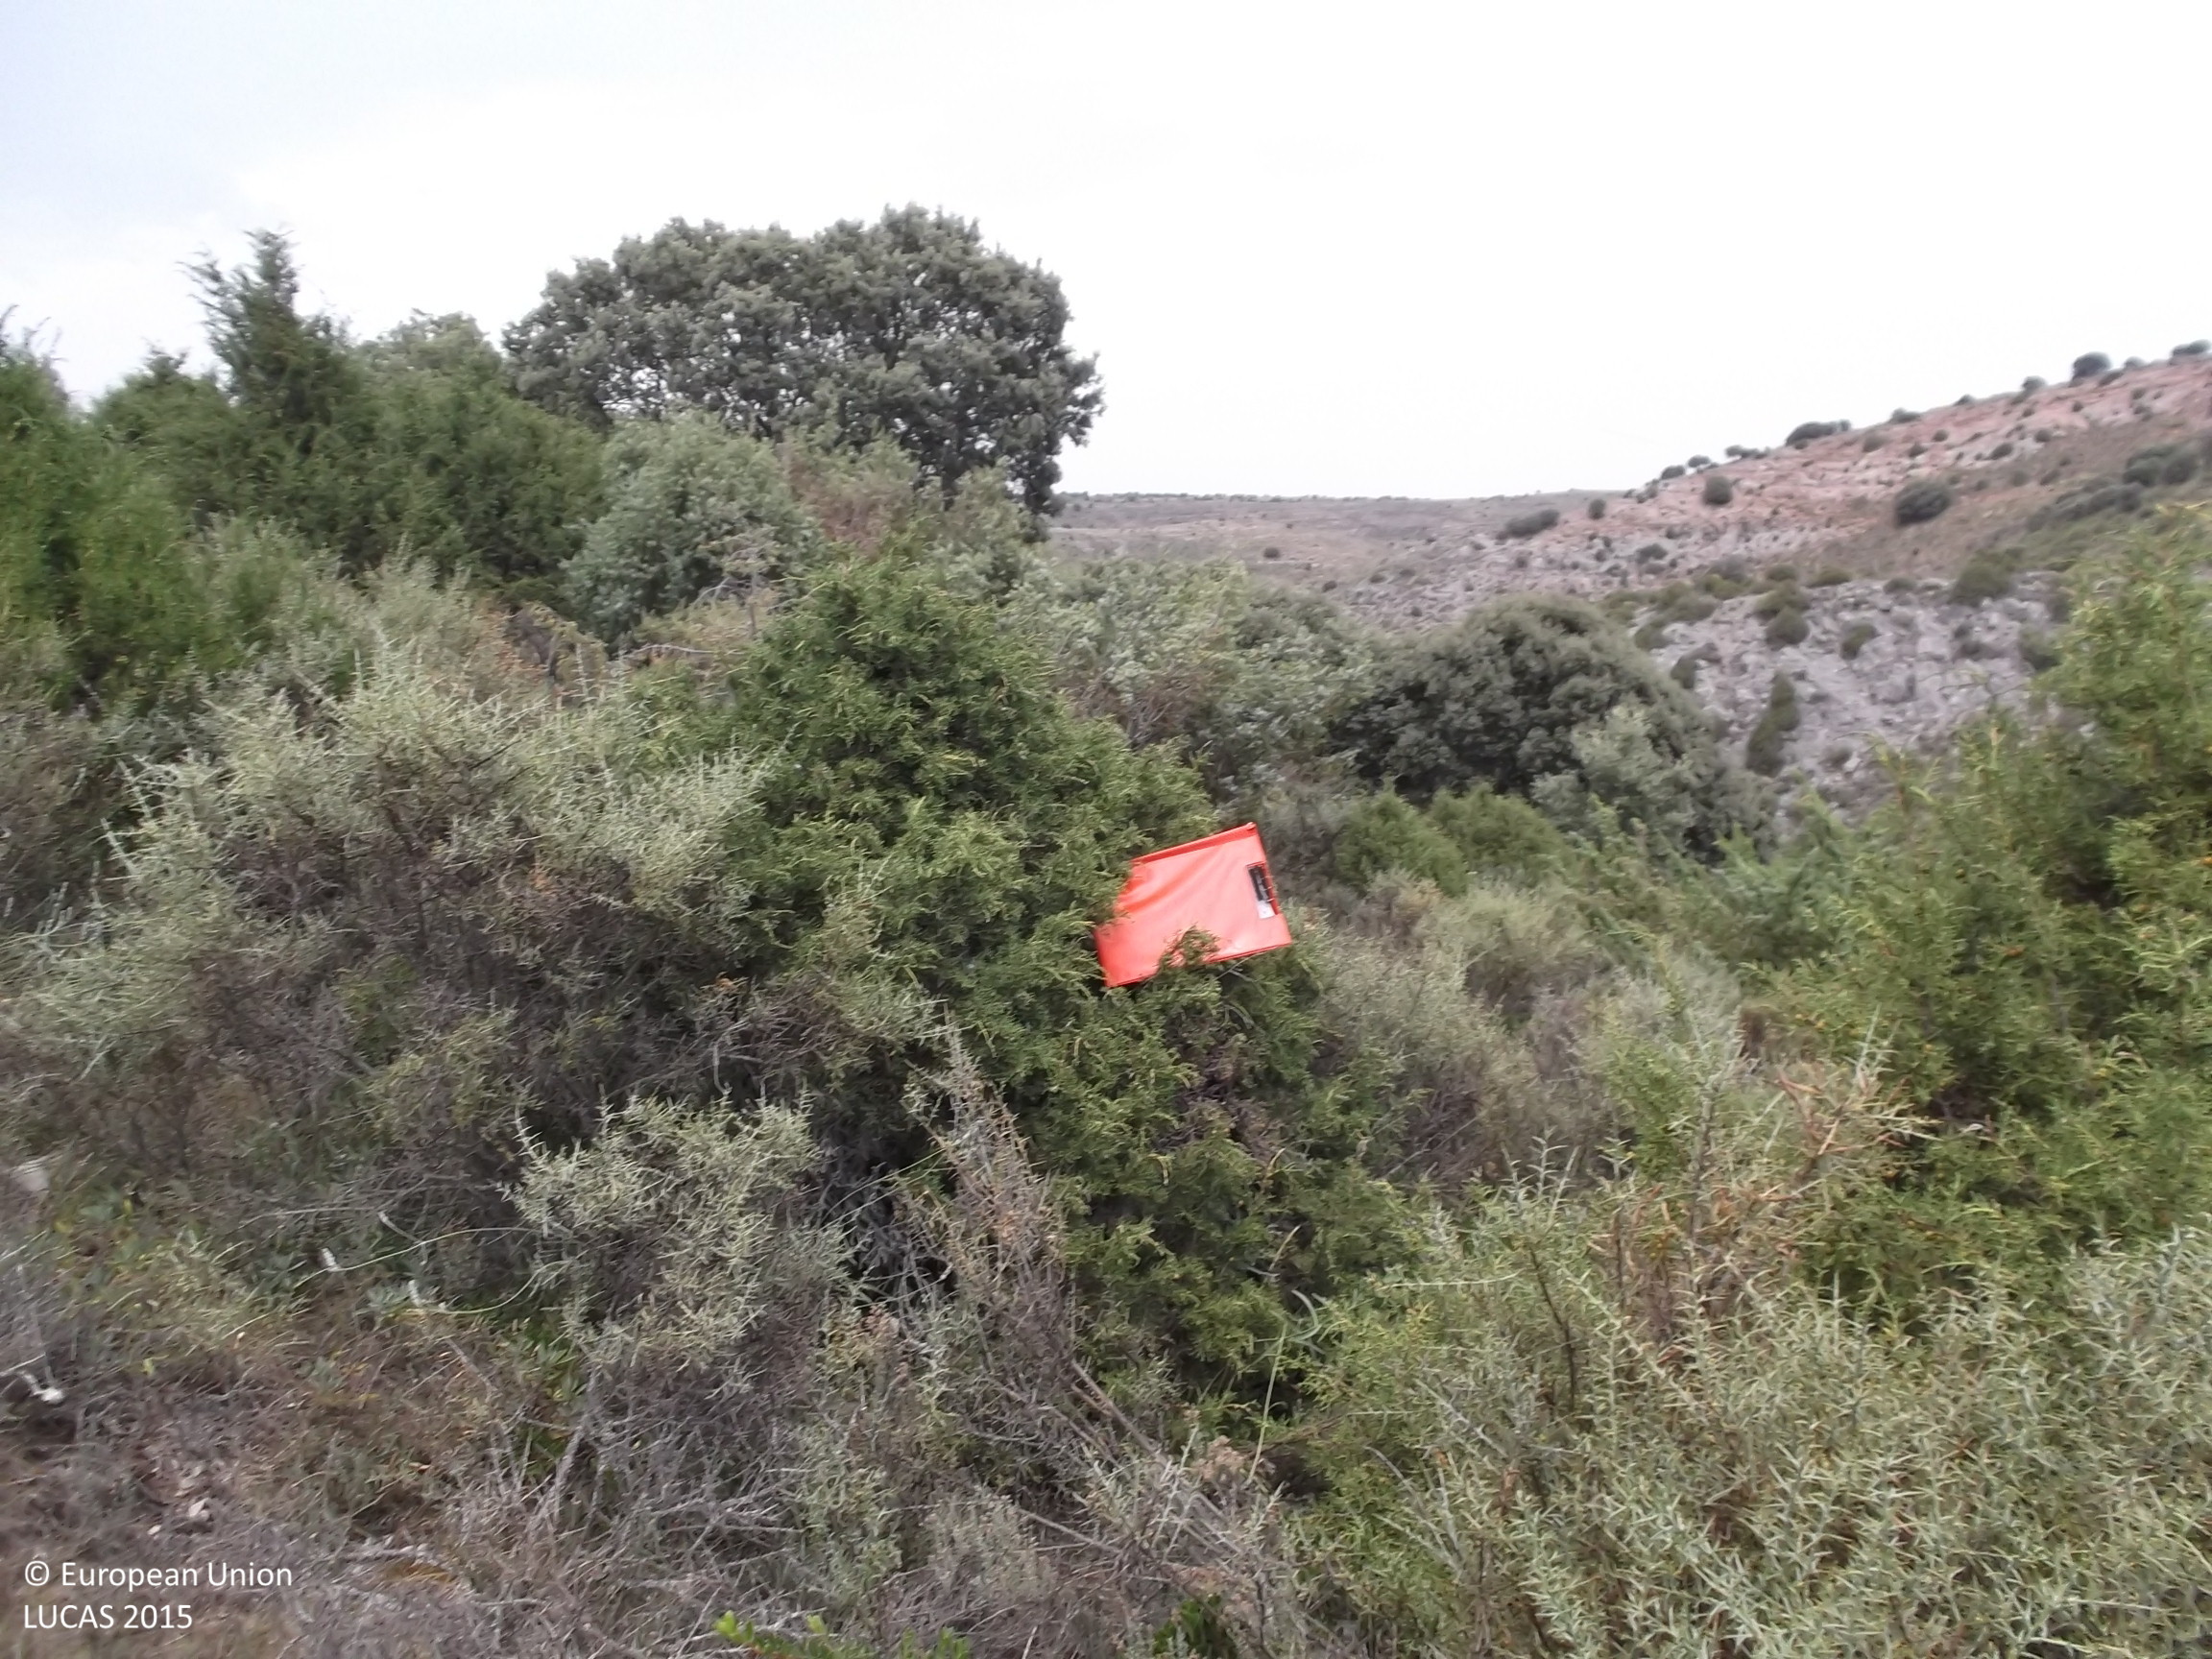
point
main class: Woodland
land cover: Other coniferous woodland
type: coniferous forest of the mediterranean region
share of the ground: 10 - 25 %
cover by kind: shrubs 70 %, coniferous forest trees 15 %, herbaceous plants 10 %, broadleaved forest trees 5 %
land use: Semi-natural and natural areas not in use
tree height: < 5 m
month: July
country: ES
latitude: 41.9038
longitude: -1.9802
